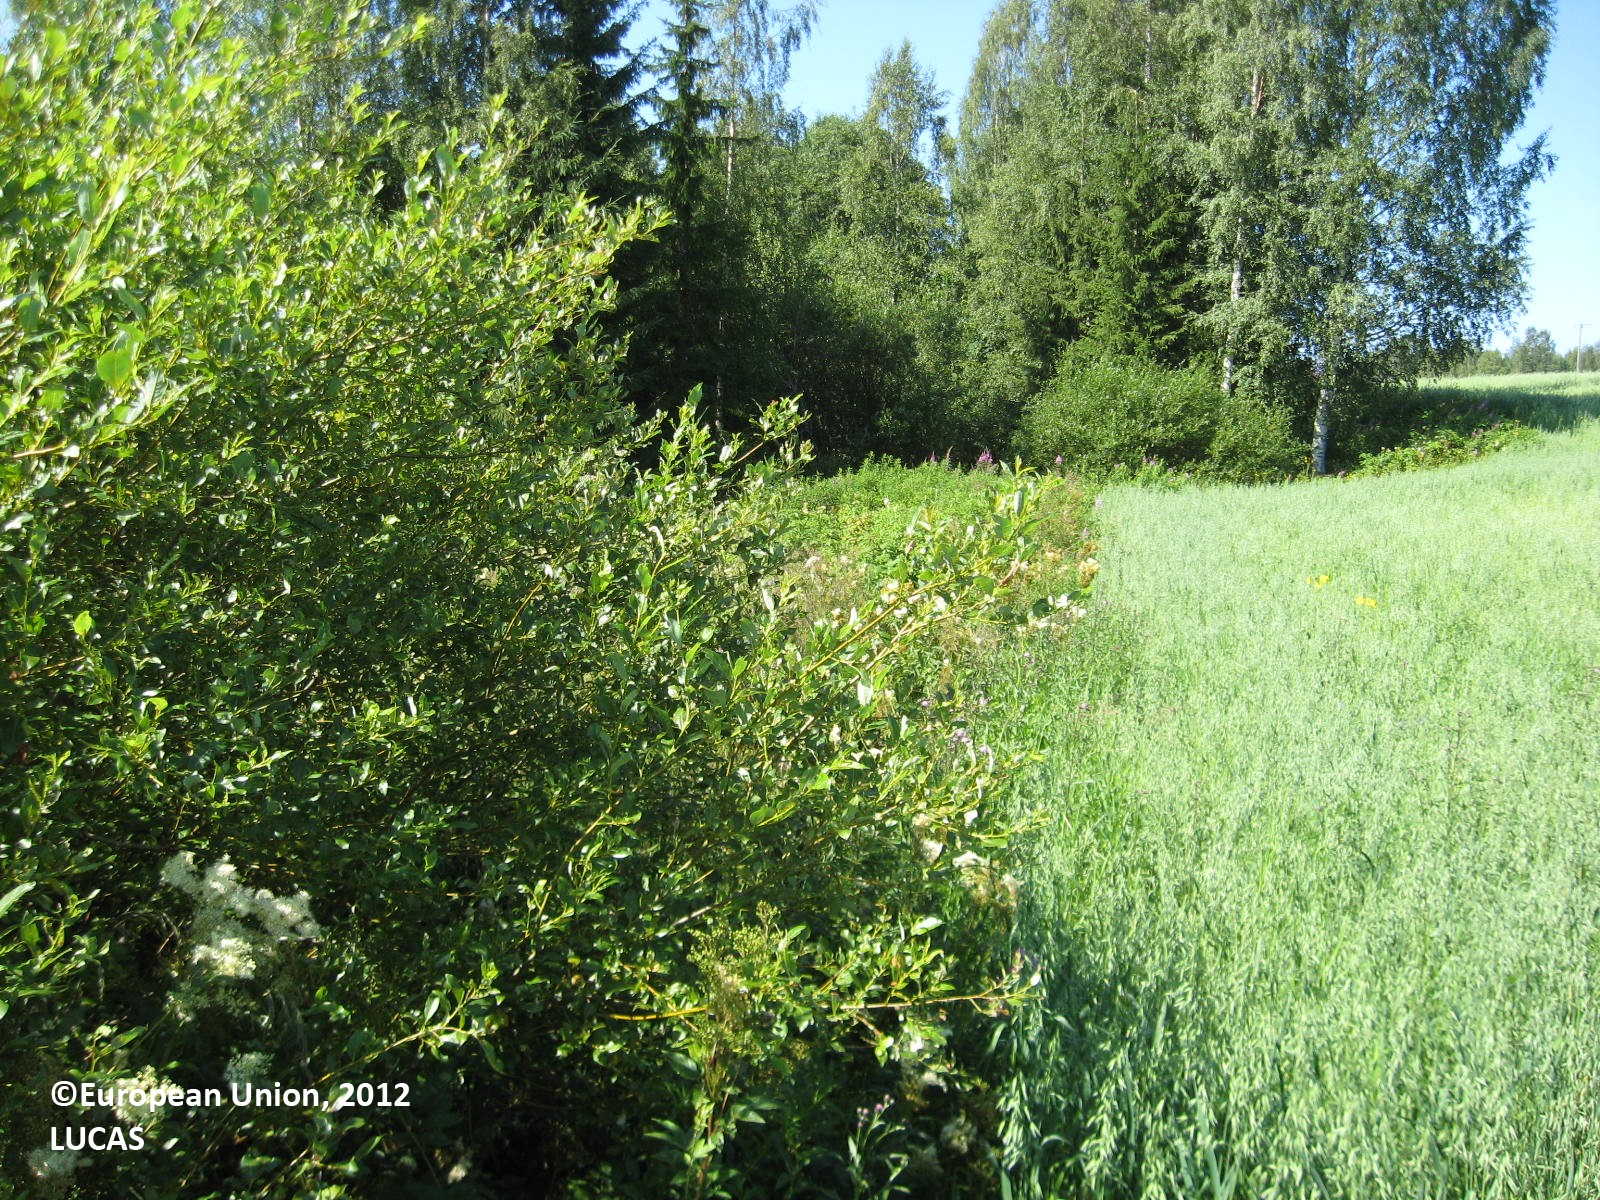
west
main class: Cropland
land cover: Oats
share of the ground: > 75 %
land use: Agriculture (excluding fallow land and kitchen gardens)
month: July
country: FI
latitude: 61.8747
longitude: 22.8636
